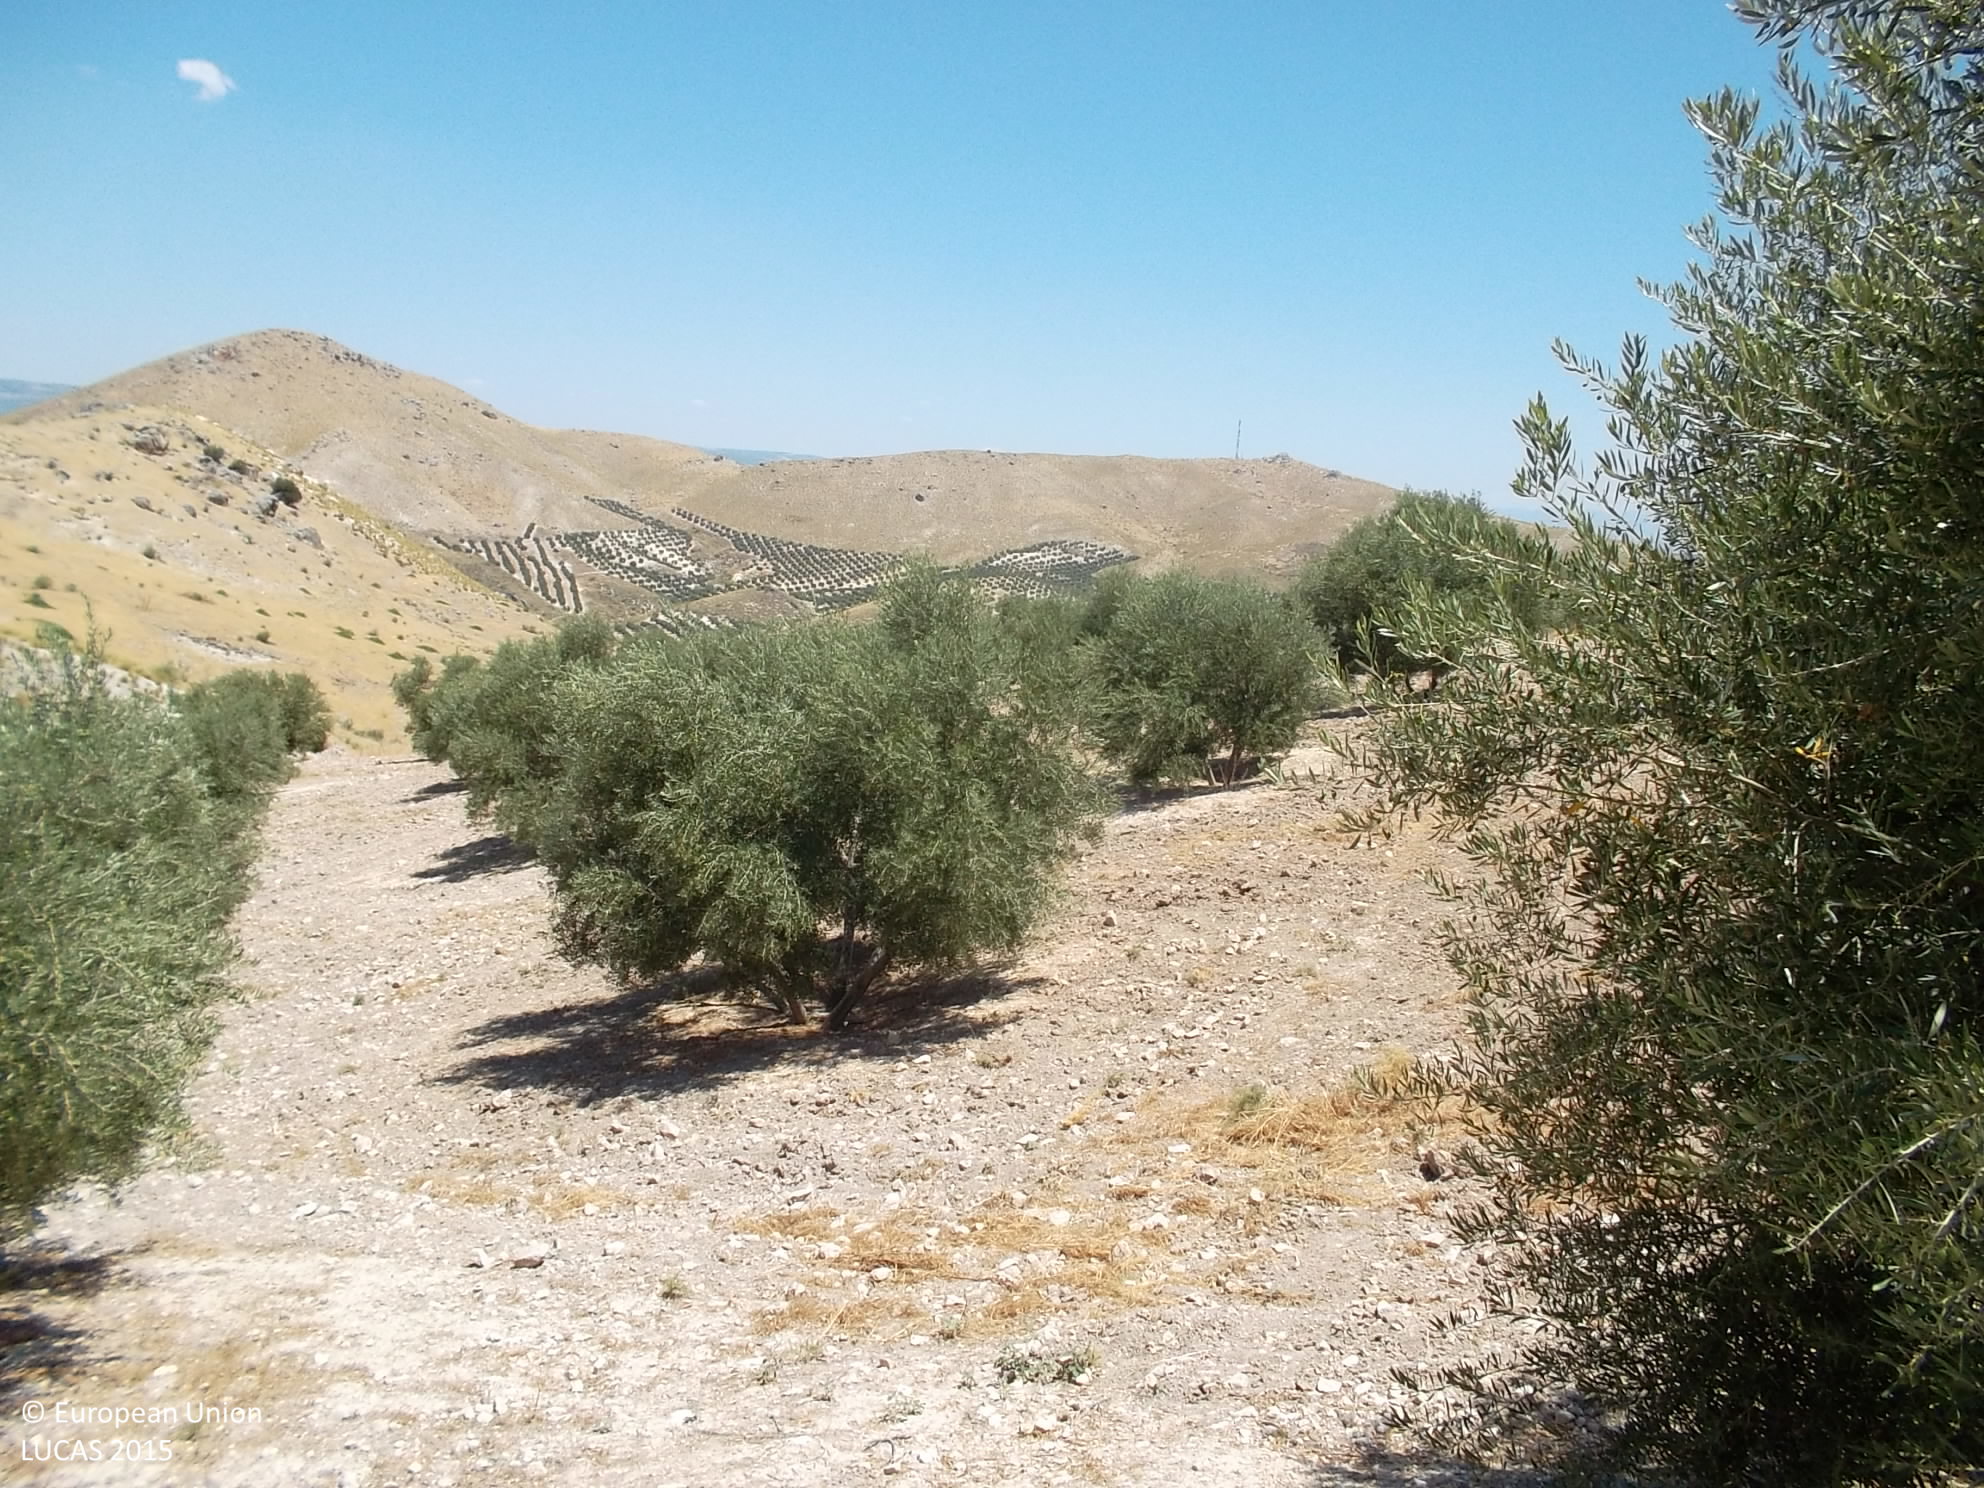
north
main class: Cropland
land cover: Olive groves
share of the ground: 25 - 50 %
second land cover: Other bare soil
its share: > 75 %
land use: Agriculture (excluding fallow land and kitchen gardens)
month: June
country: ES
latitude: 37.8800
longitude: -3.3800
